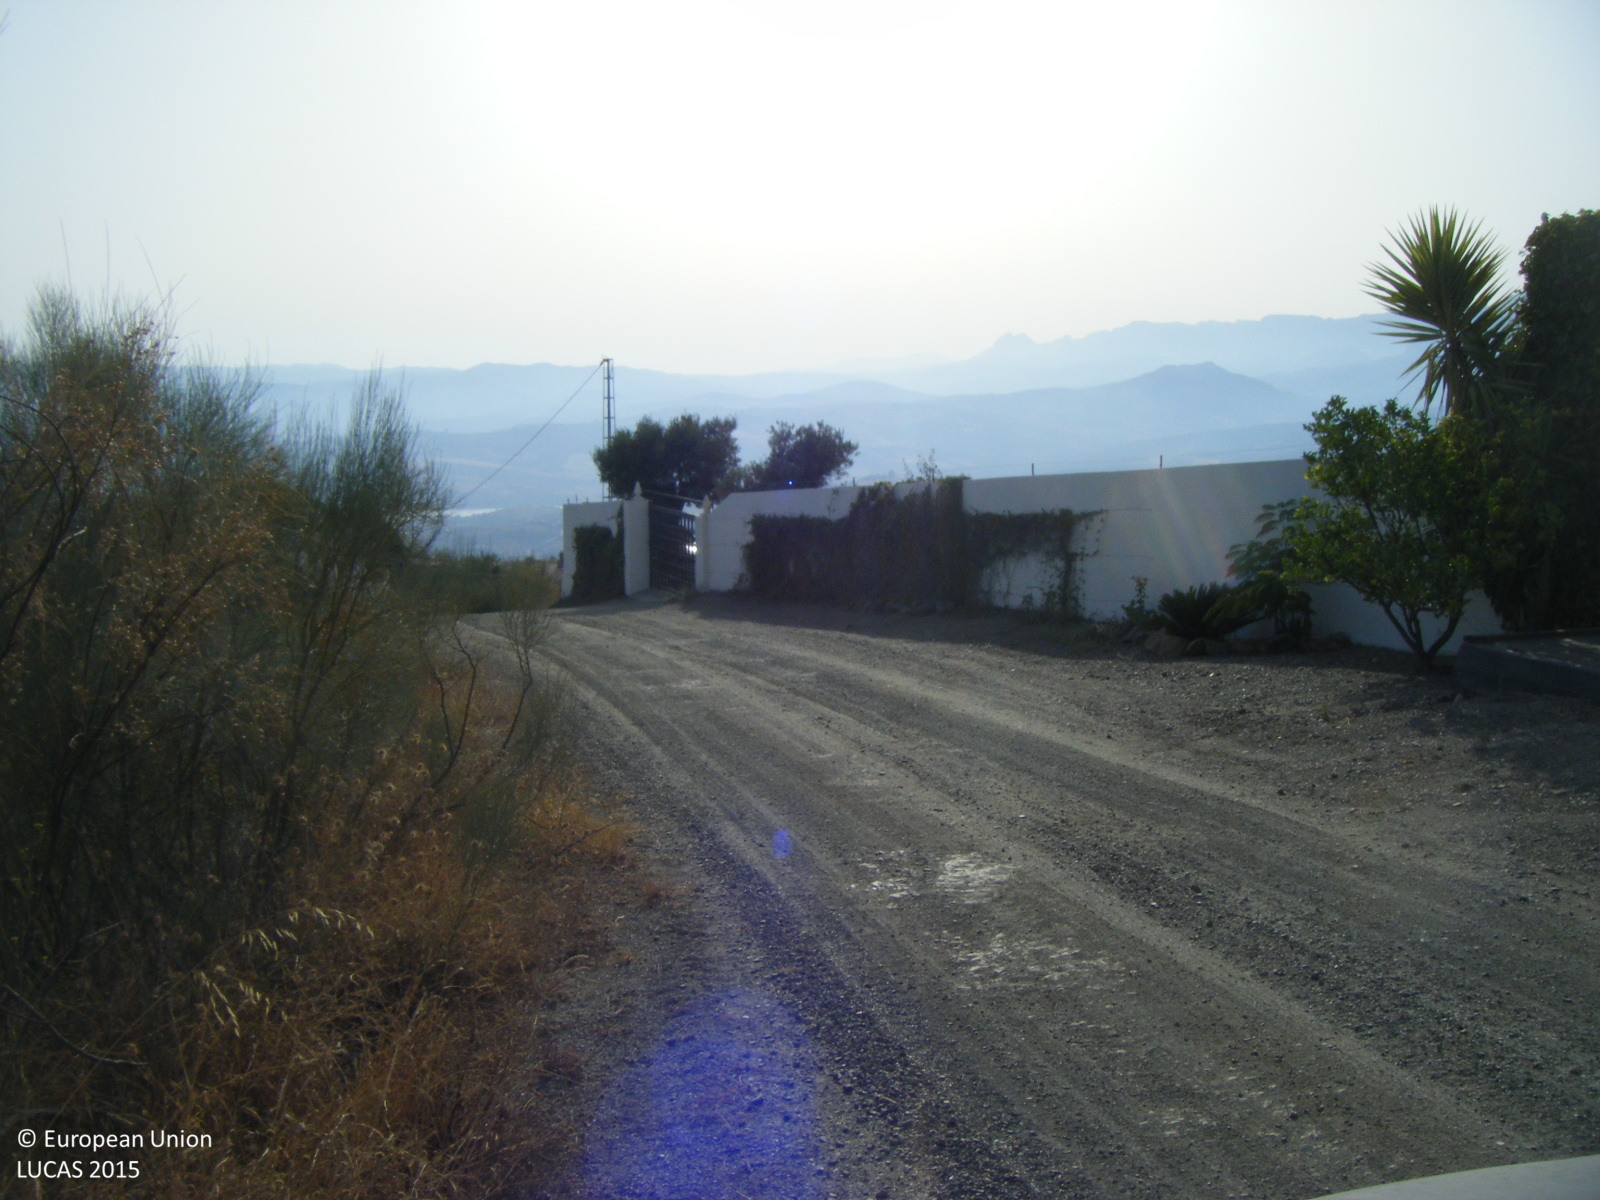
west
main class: Cropland
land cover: Olive groves
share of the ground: 10 - 25 %
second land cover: Spontaneously vegetated surfaces
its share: > 75 %
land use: Agriculture (excluding fallow land and kitchen gardens)
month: July
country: ES
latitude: 36.8909
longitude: -4.1168
